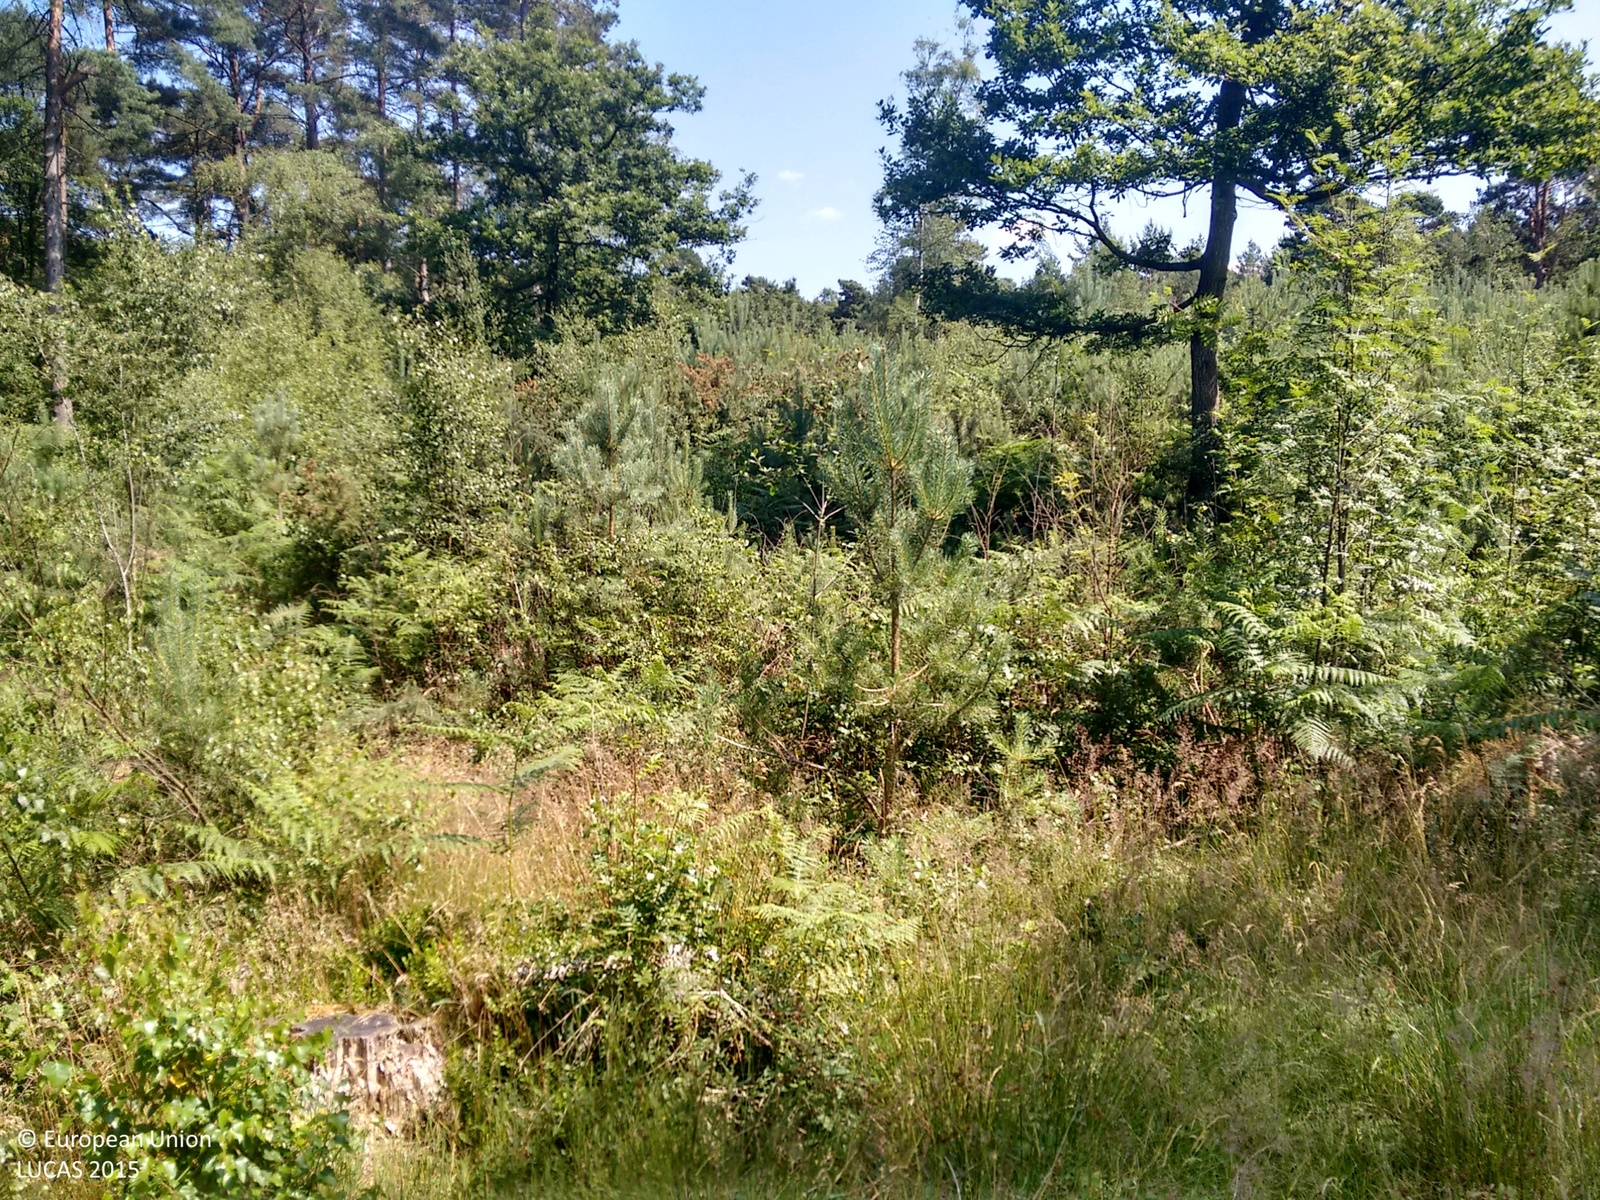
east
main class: Shrubland
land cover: Shrubland with sparse tree cover
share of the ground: > 75 %
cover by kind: shrubs 95 %, broadleaved forest trees 5 %
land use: Forestry
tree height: > 5 m
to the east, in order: Shrubland with sparse tree cover; Electric lines; Pine dominated coniferous woodland; Spontaneously vegetated surfaces; Tracks; Pine dominated coniferous woodland; Broadleaved woodland
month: July
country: GB
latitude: 51.1905
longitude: -0.4400
